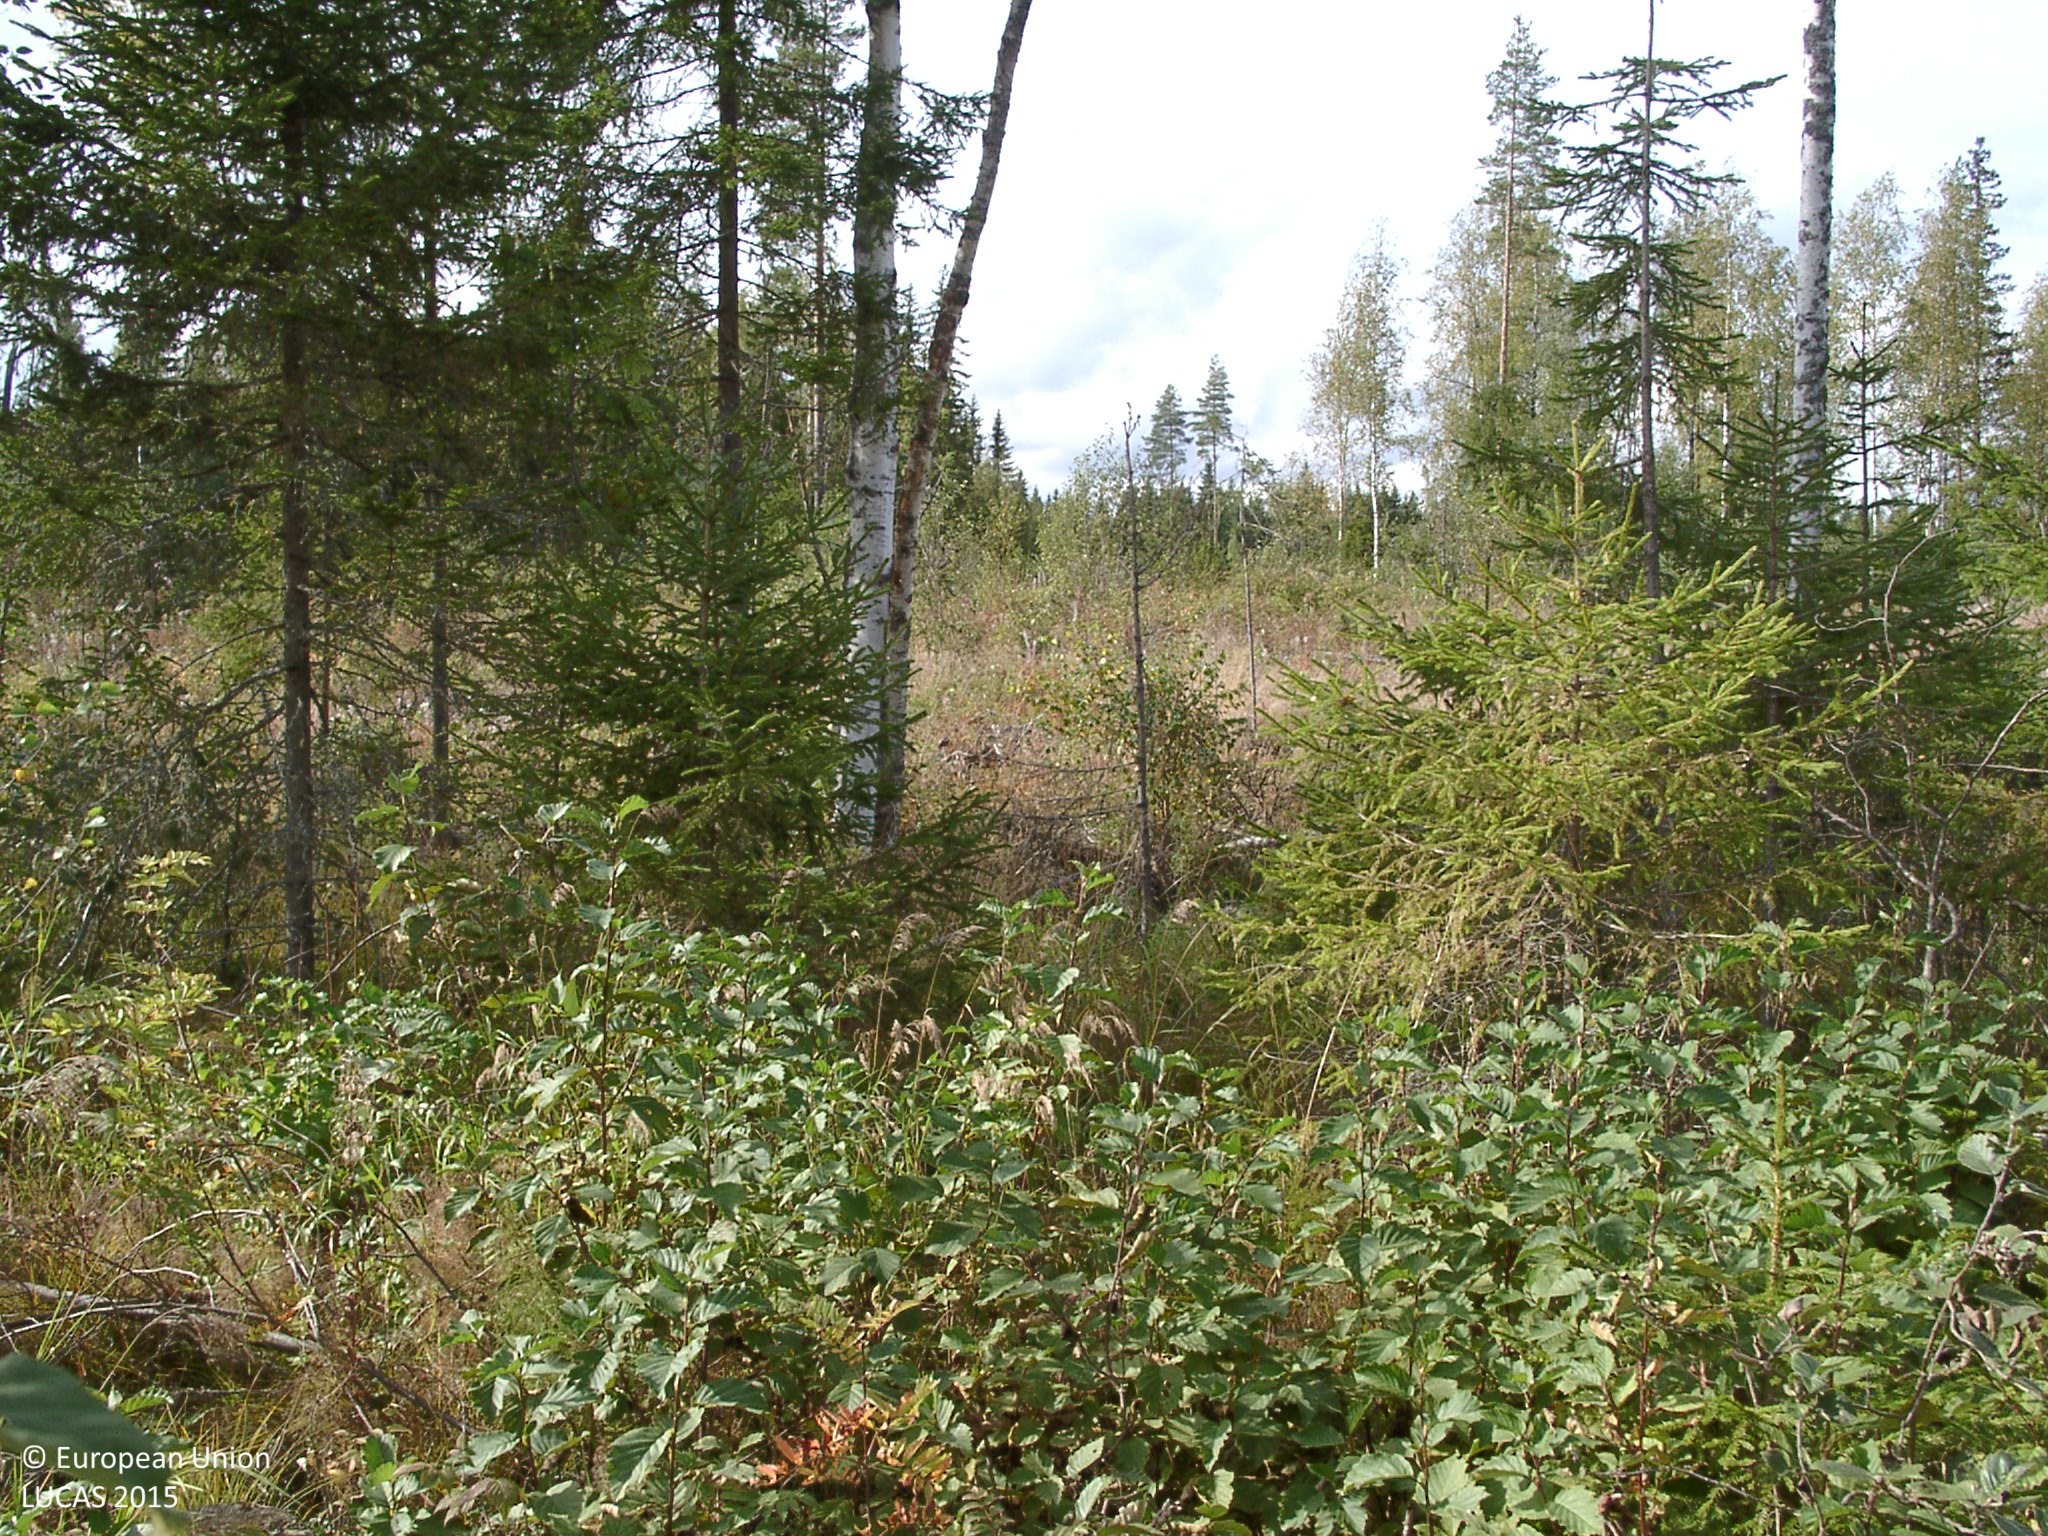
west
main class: Woodland
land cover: Spruce dominated mixed woodland
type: boreal forest
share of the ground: 10 - 25 %
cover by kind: herbaceous plants 75 %, lichens and mosses 10 %, coniferous forest trees 5 %, broadleaved forest trees 5 %, shrubs 5 %
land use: Forestry
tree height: < 5 m
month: September
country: FI
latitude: 62.5231
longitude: 25.8367
